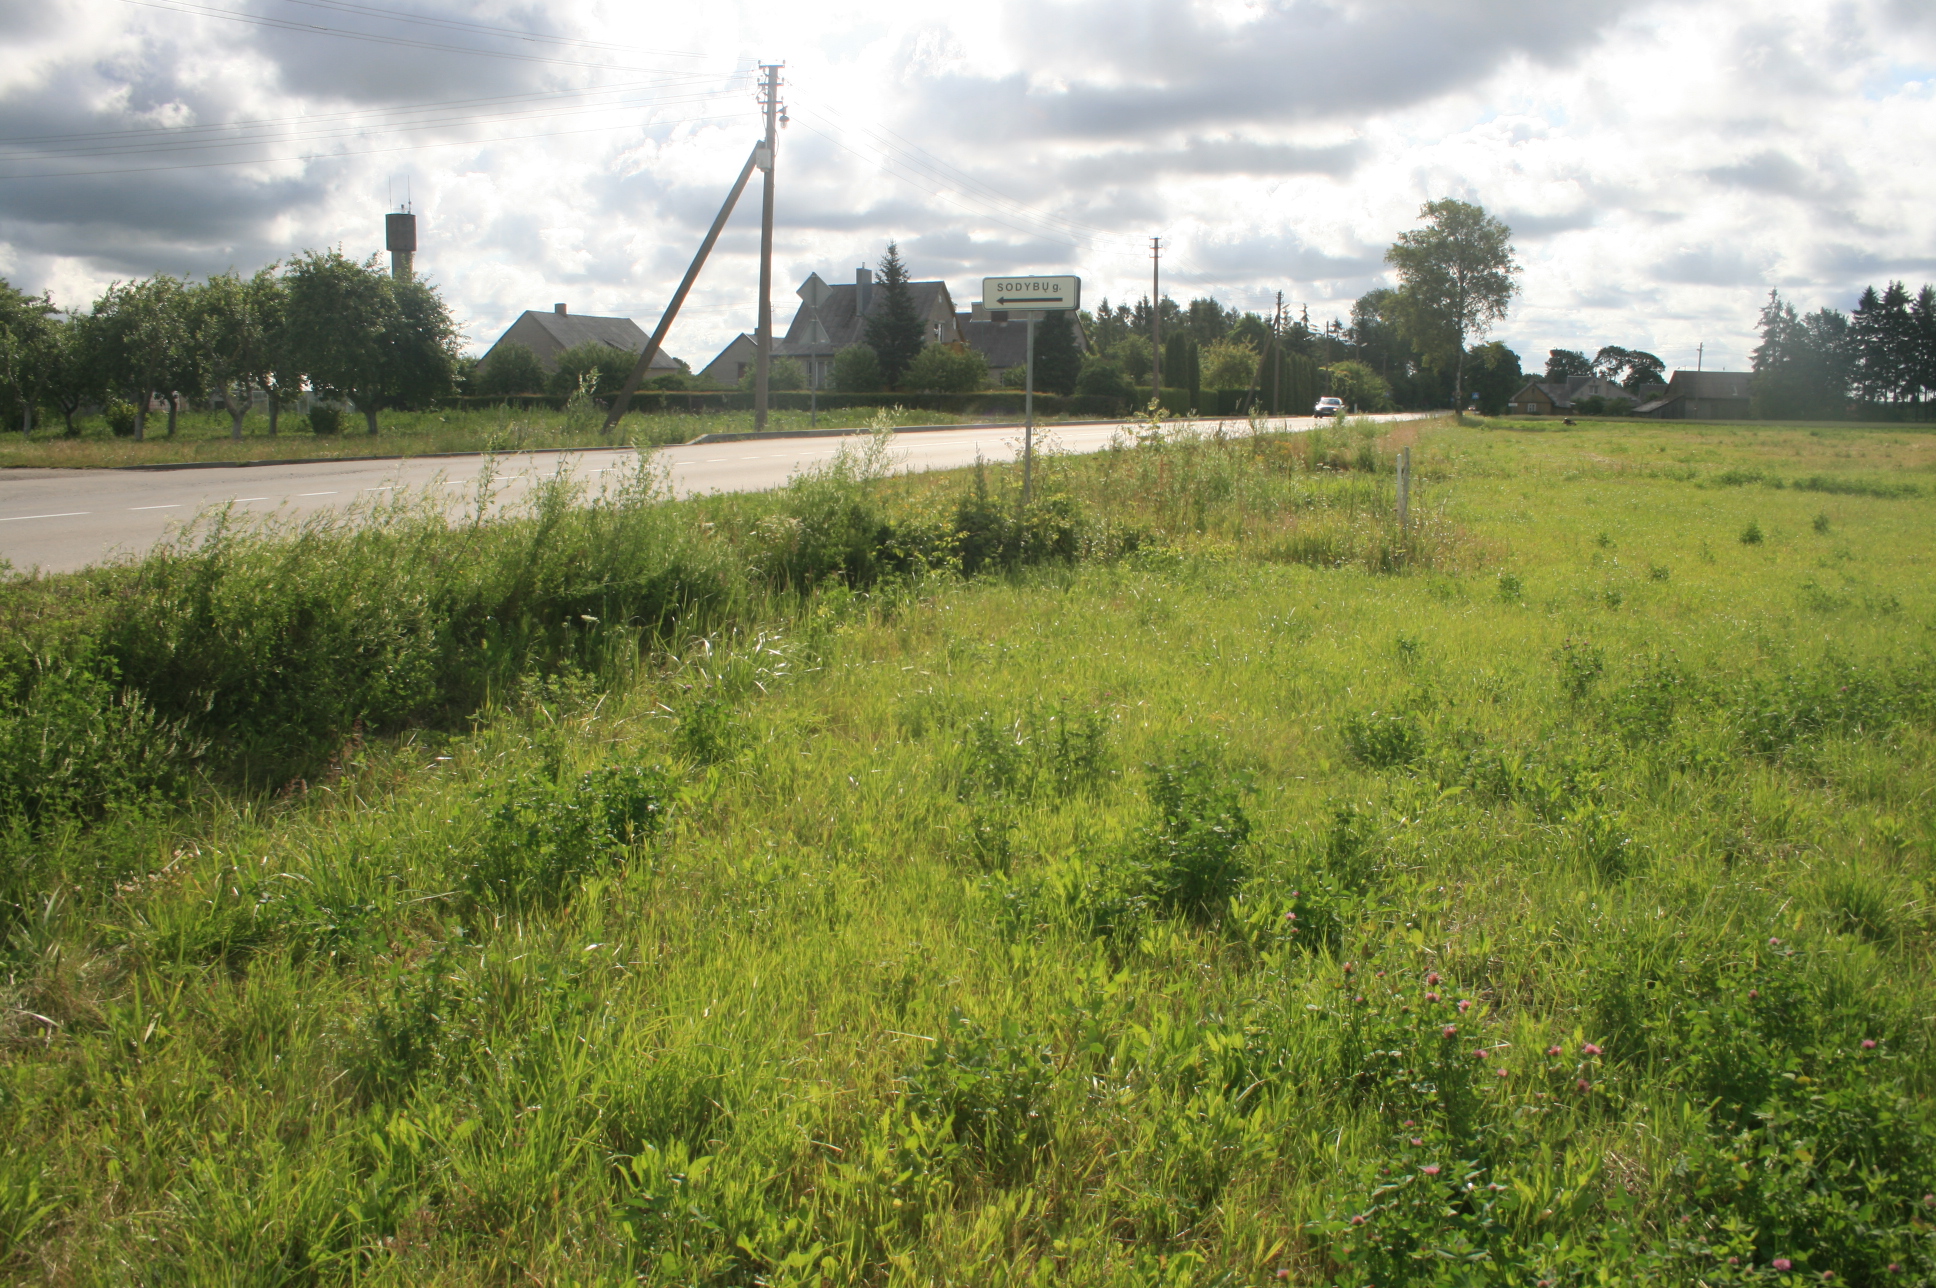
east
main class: Grassland
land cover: Grassland without tree/shrub cover
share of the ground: > 75 %
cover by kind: herbaceous plants 100 %
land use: Agriculture (excluding fallow land and kitchen gardens)
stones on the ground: < 10 %
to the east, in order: Grassland without tree/shrub cover; Paved roads, cycling and walking lanes; Grass margins; Electric lines; Grass margins; Potatoes; Other root crops; Grassland without tree/shrub cover; Artificial constructions in urban areas; Potatoes; Grassland without tree/shrub cover; Apple fruit; Grass margins; Other root crops
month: July
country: LT
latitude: 55.8622
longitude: 21.3712
